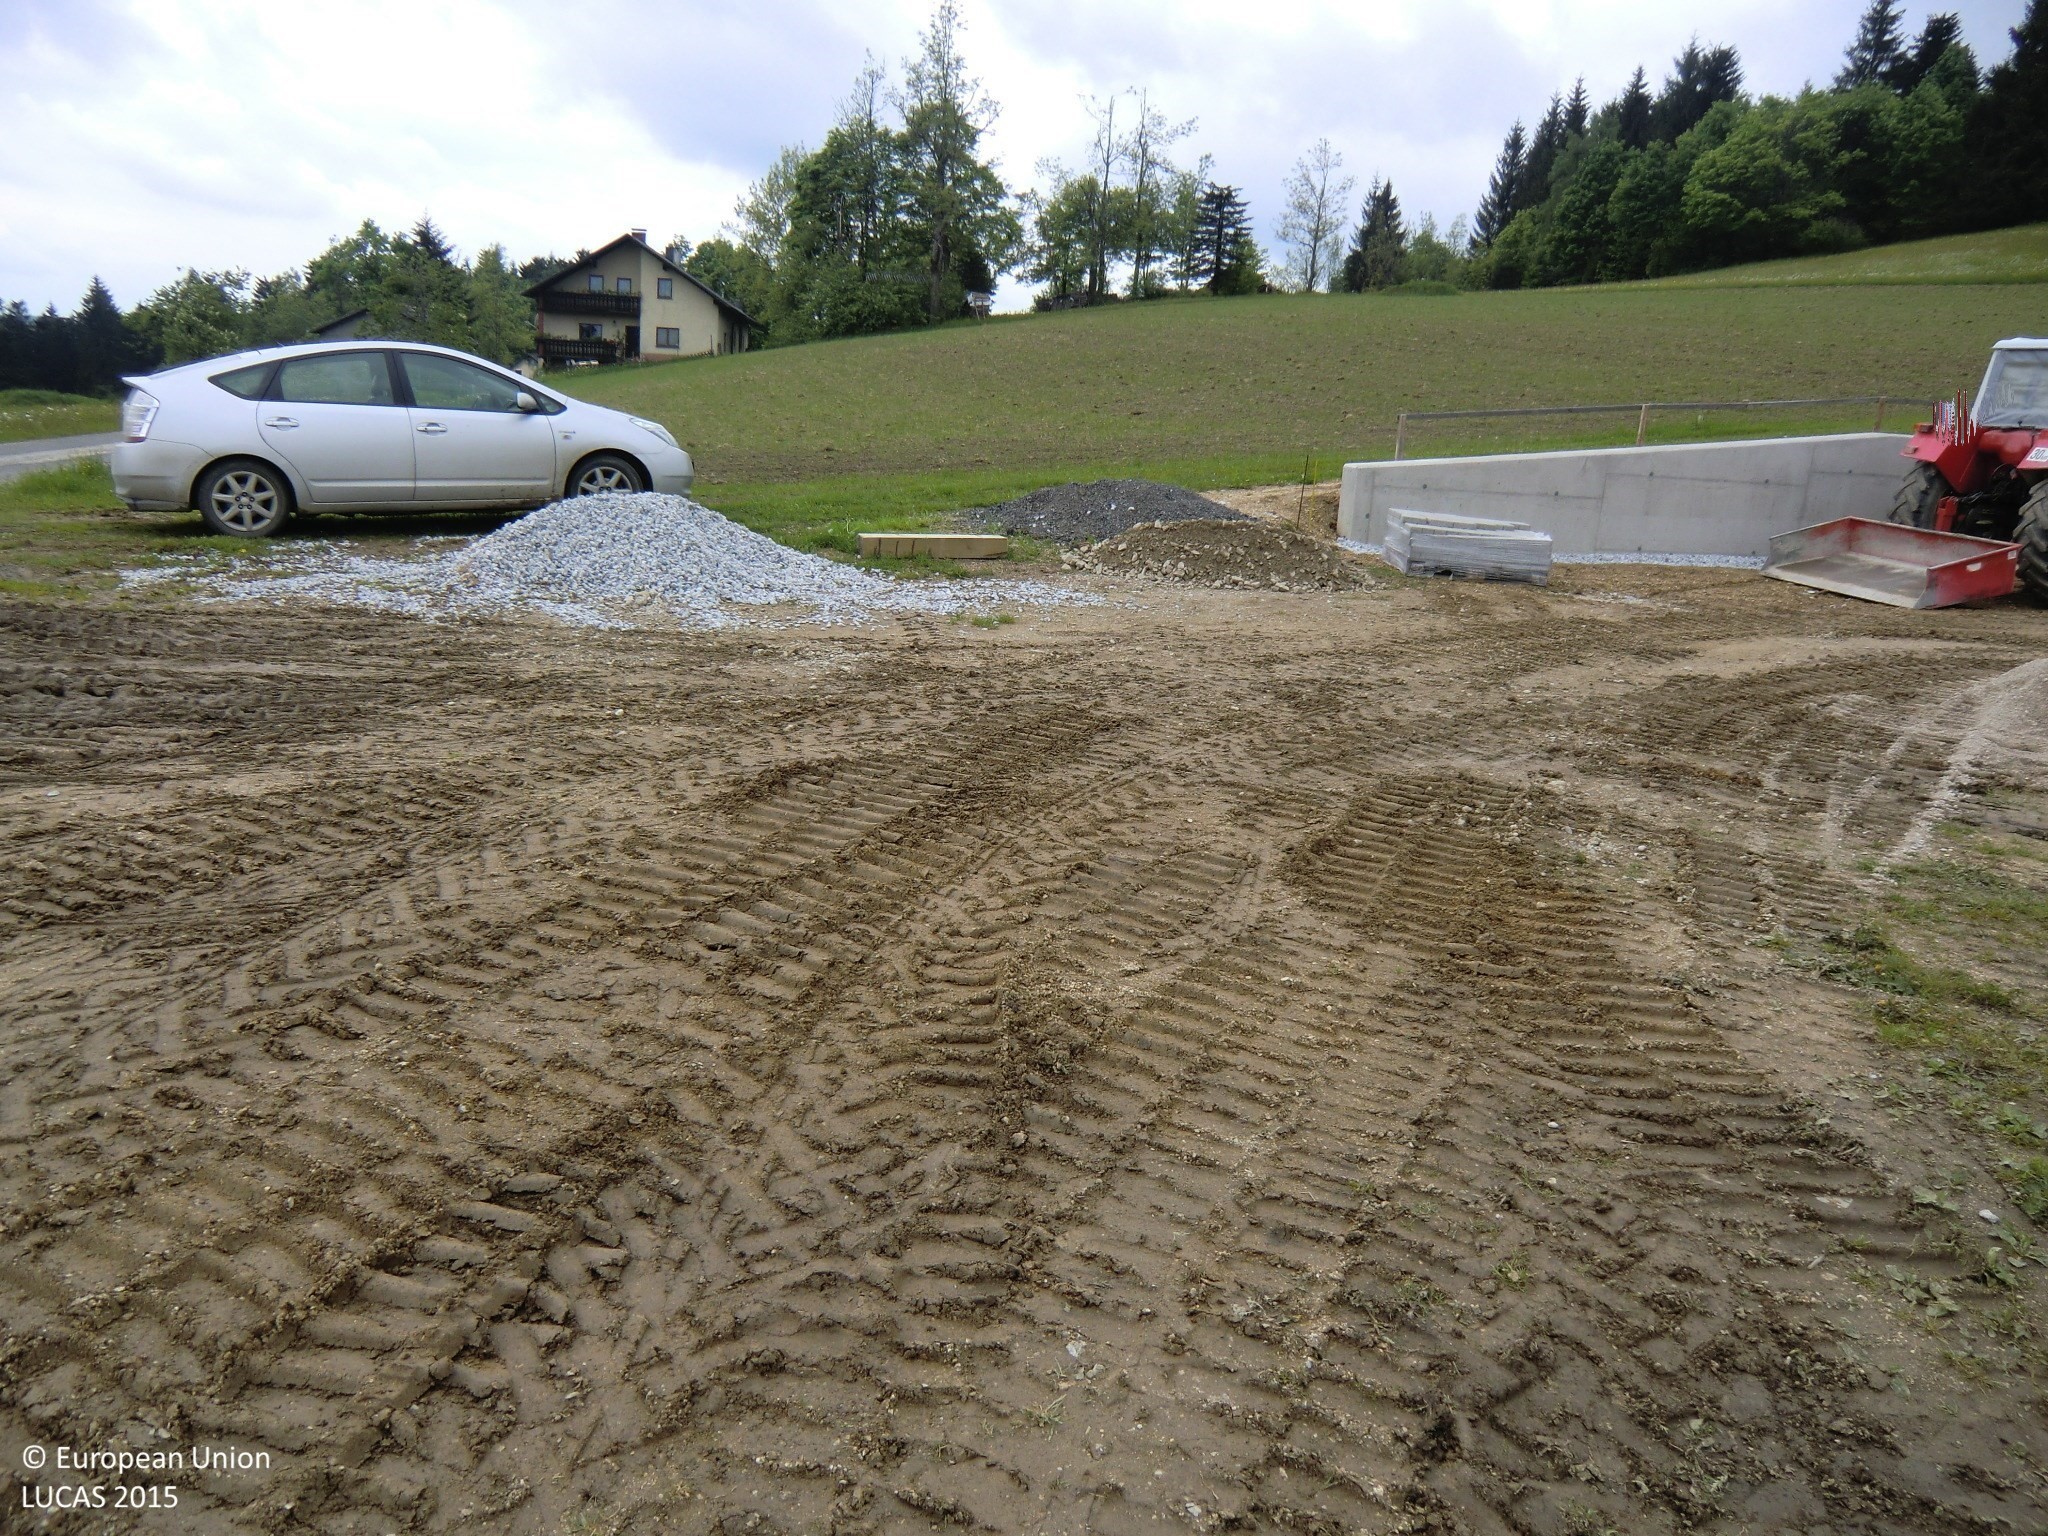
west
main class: Grassland
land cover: Spontaneously vegetated surfaces
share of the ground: 25 - 50 %
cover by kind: herbaceous plants 50 %, unconsolidated bare surface 50 %
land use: Residential
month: May
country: AT
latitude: 48.4363
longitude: 14.9621
